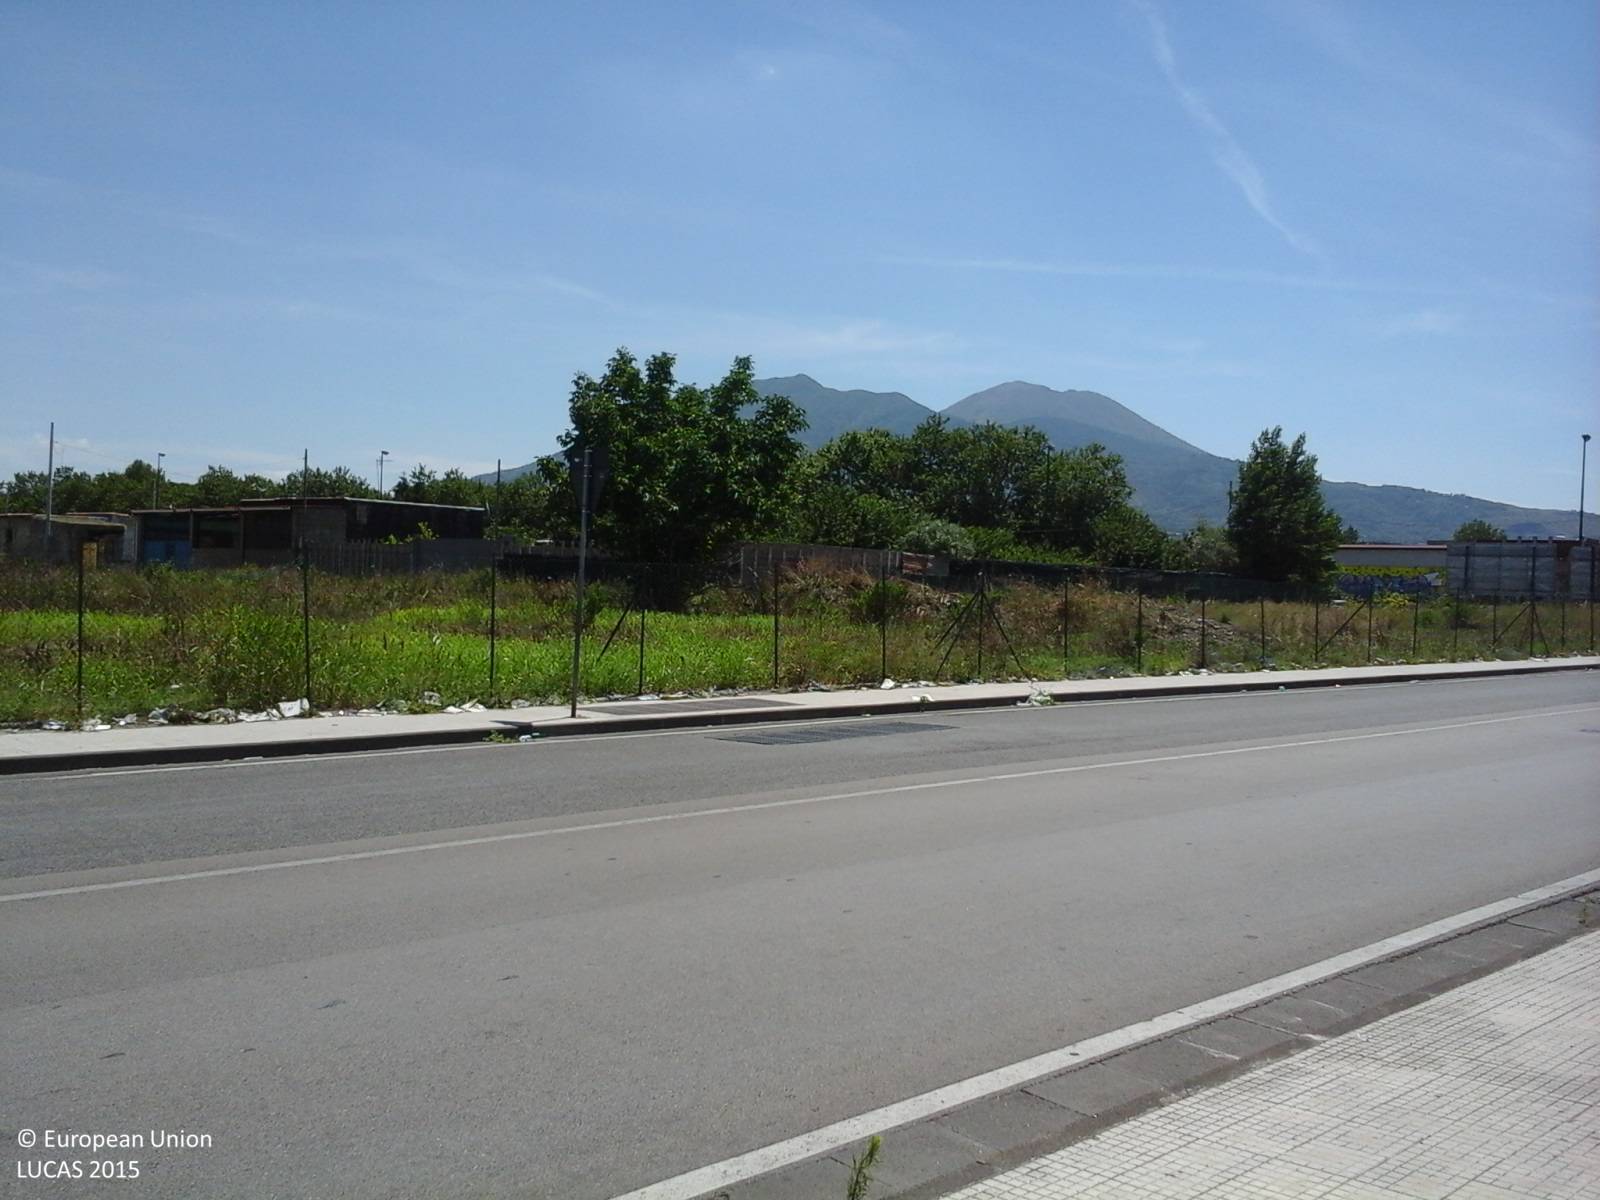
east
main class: Shrubland
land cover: Shrubland with sparse tree cover
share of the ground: > 75 %
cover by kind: shrubs 50 %, herbaceous plants 45 %, broadleaved forest trees 5 %
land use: Abandoned areas
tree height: < 5 m
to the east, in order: Shrubland with sparse tree cover; Paved roads, cycling and walking lanes; Fences; Grassland without tree/shrub cover; Artificial constructions in urban areas
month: June
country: IT
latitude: 40.8600
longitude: 14.3359
